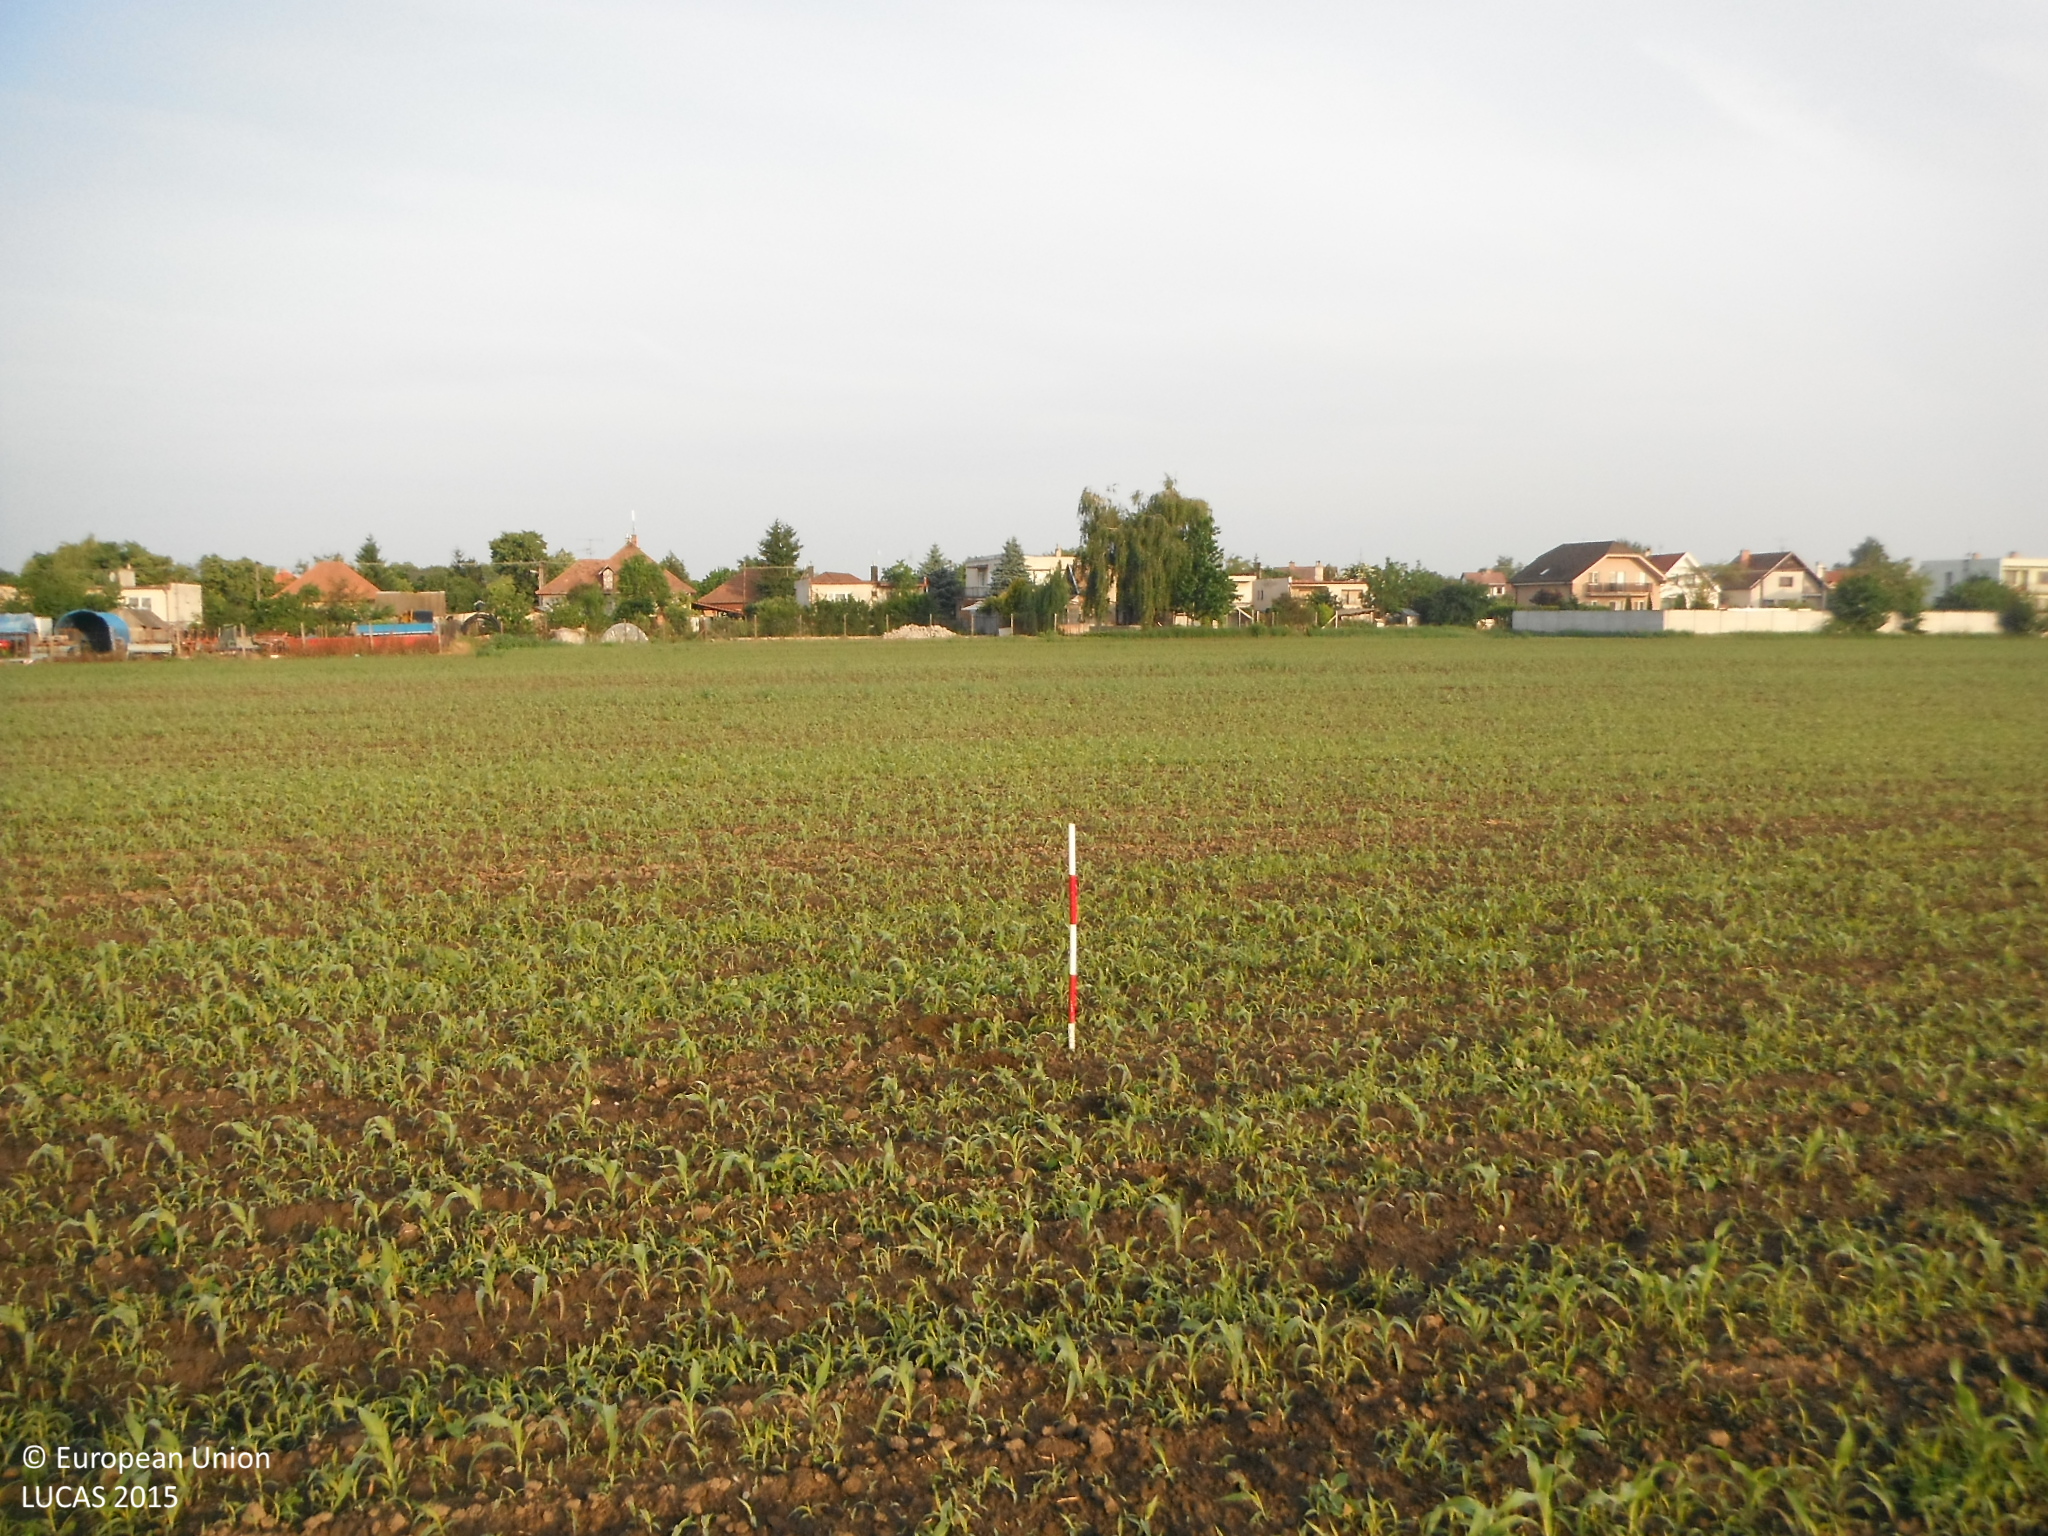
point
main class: Cropland
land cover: Maize
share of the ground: 10 - 25 %
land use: Agriculture (excluding fallow land and kitchen gardens)
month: May
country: SK
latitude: 48.1919
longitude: 17.3948
